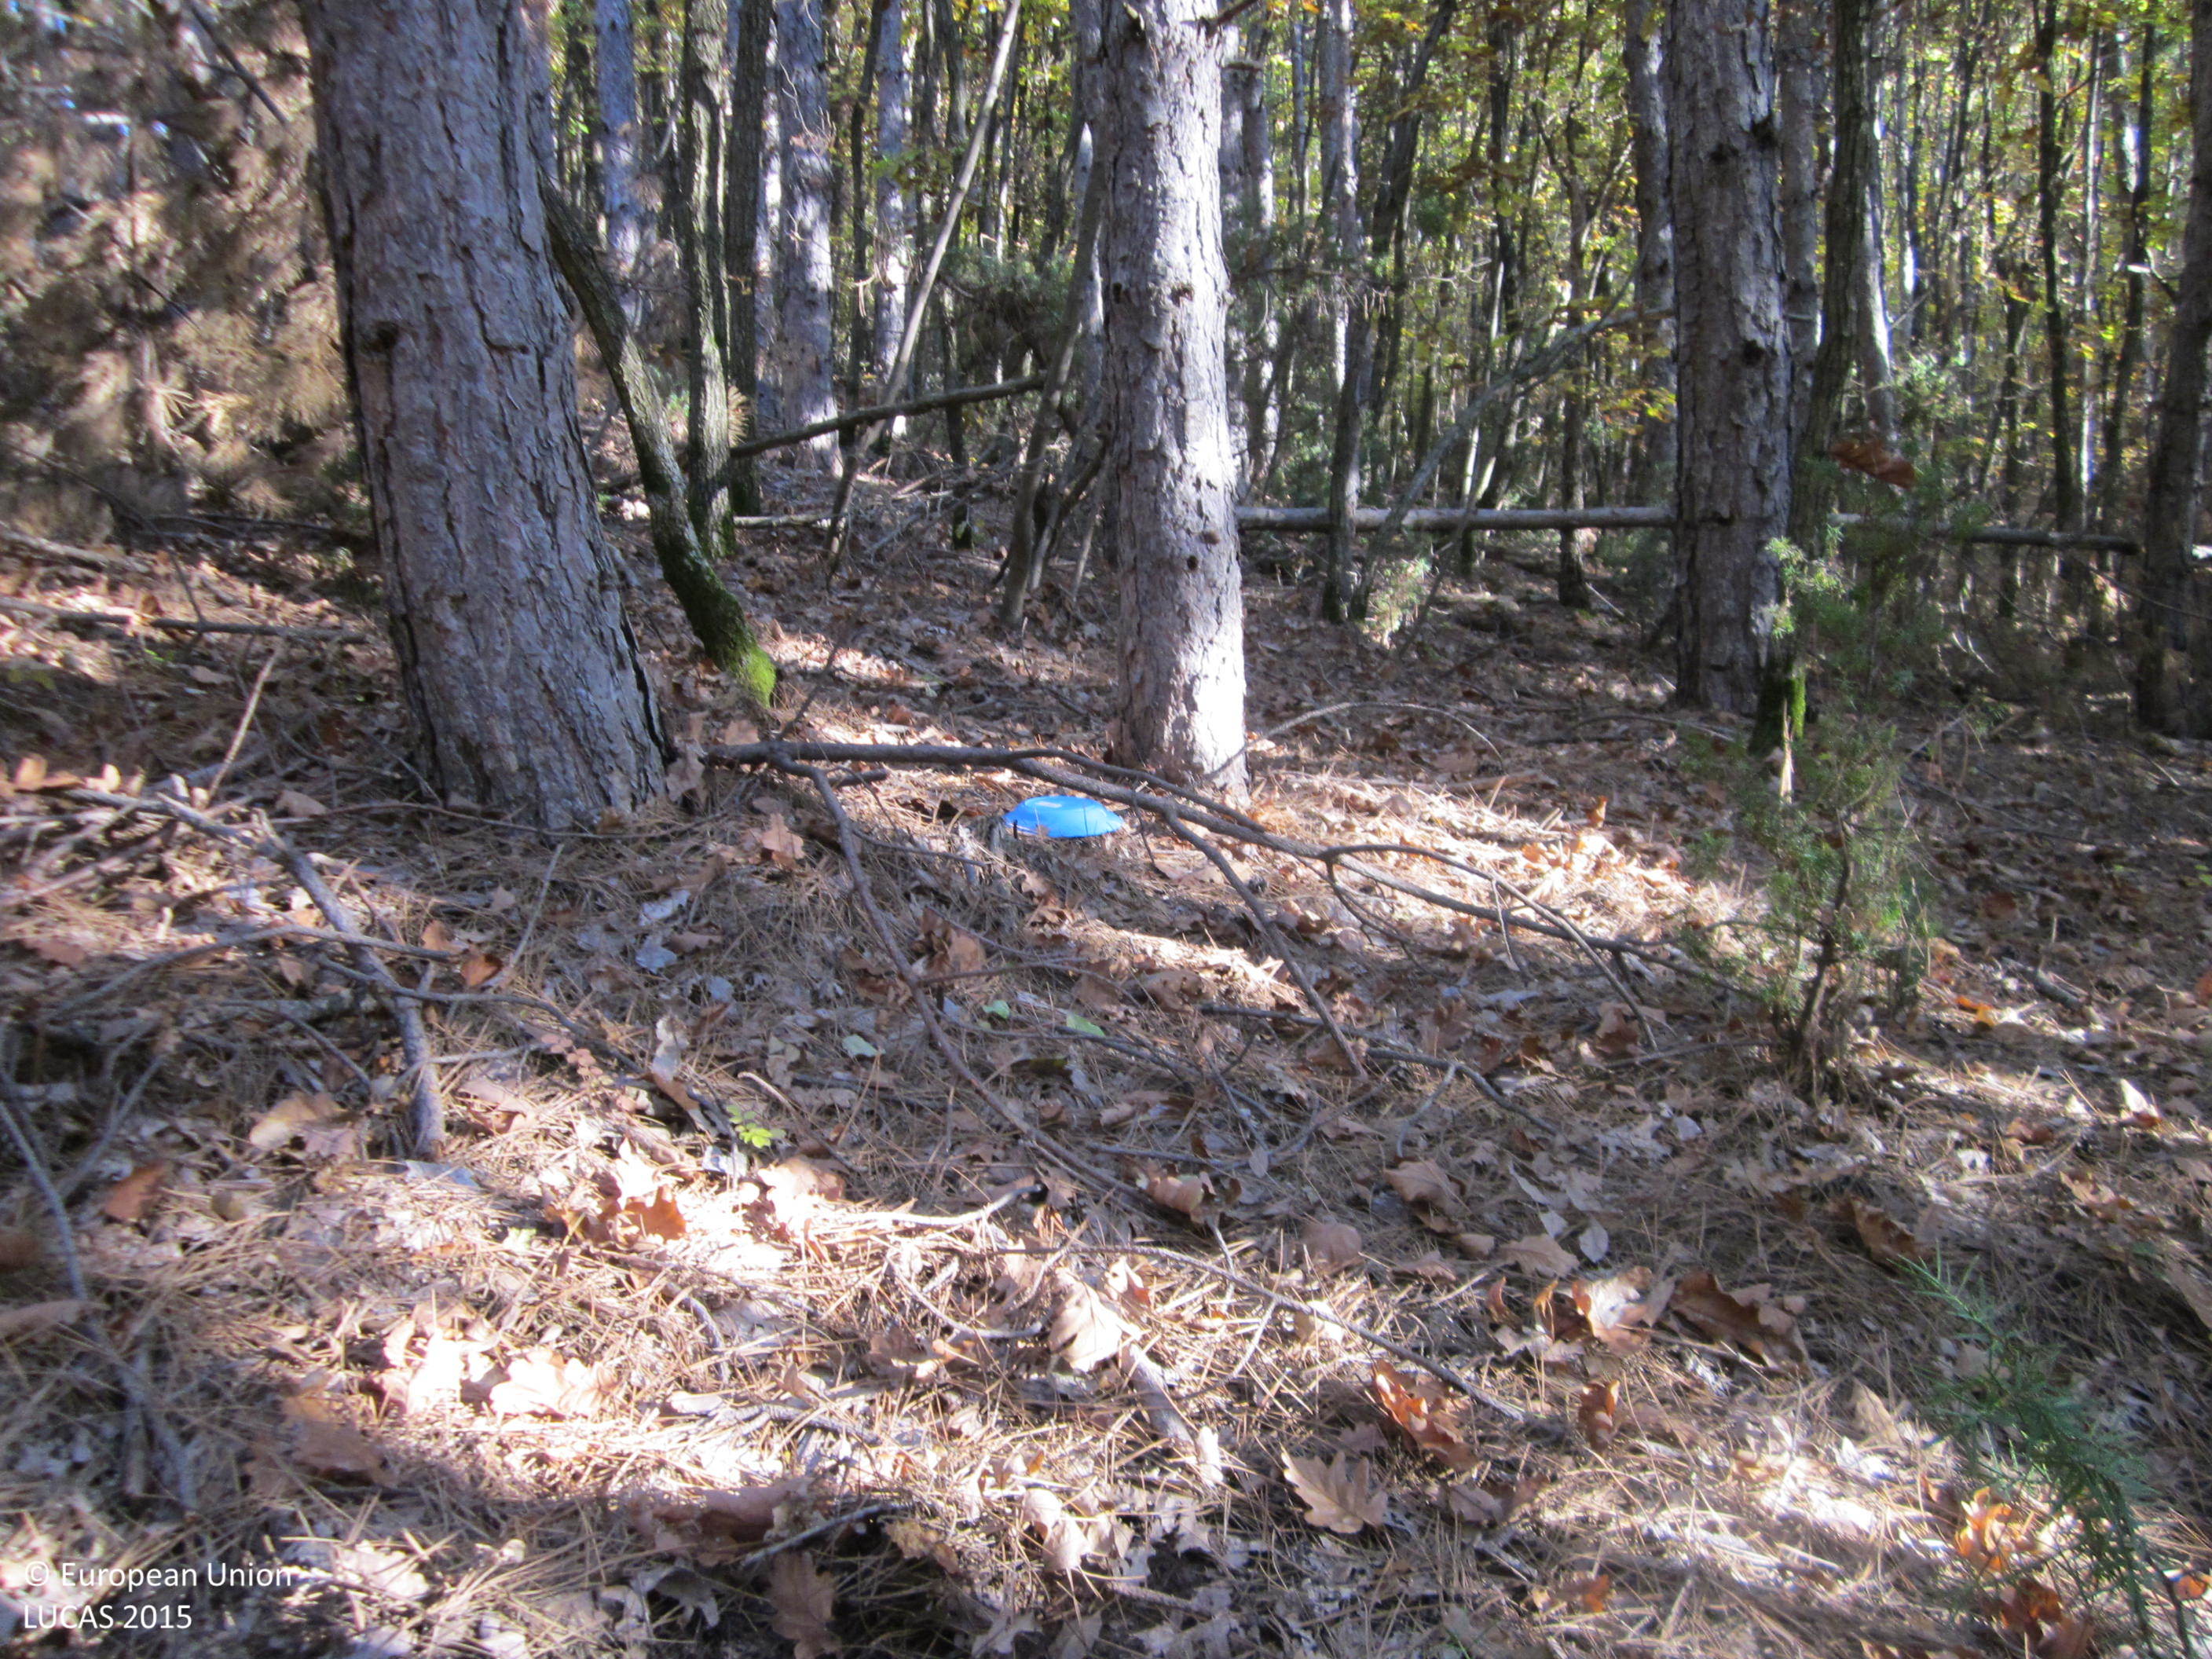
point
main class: Woodland
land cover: Pine dominated mixed woodland
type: hemiboreal forest and nemoral coniferous forest and mixed broadleaved-coniferous forest
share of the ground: > 75 %
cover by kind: coniferous forest trees 60 %, broadleaved forest trees 20 %, unconsolidated bare surface 15 %, lichens and mosses 5 %
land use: Forestry
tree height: > 5 m
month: November
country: BG
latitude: 41.5621
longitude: 25.7352
